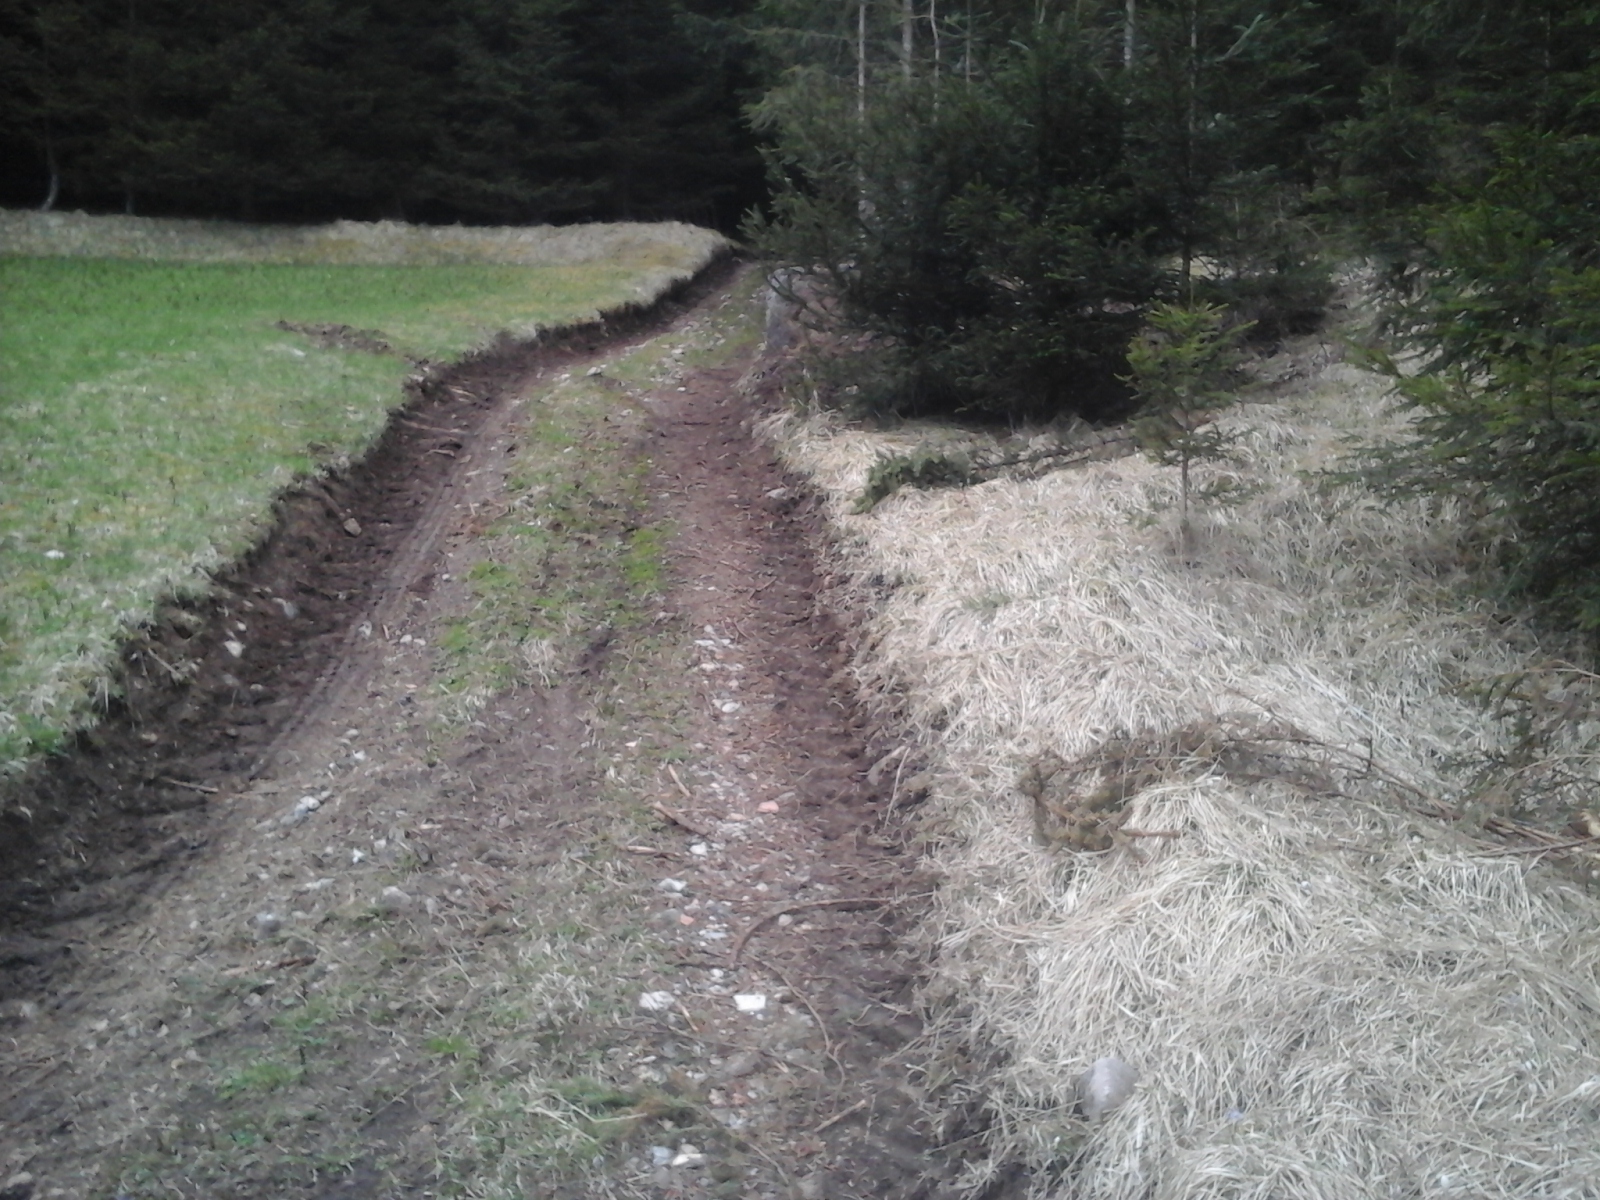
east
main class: Woodland
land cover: Spruce dominated coniferous woodland
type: alpine coniferous forest
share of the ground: > 75 %
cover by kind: coniferous forest trees 100 %
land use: Forestry
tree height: > 5 m
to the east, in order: Spruce dominated coniferous woodland; Grassland without tree/shrub cover; Spruce dominated coniferous woodland
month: May
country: IT
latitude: 46.3921
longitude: 11.6755
